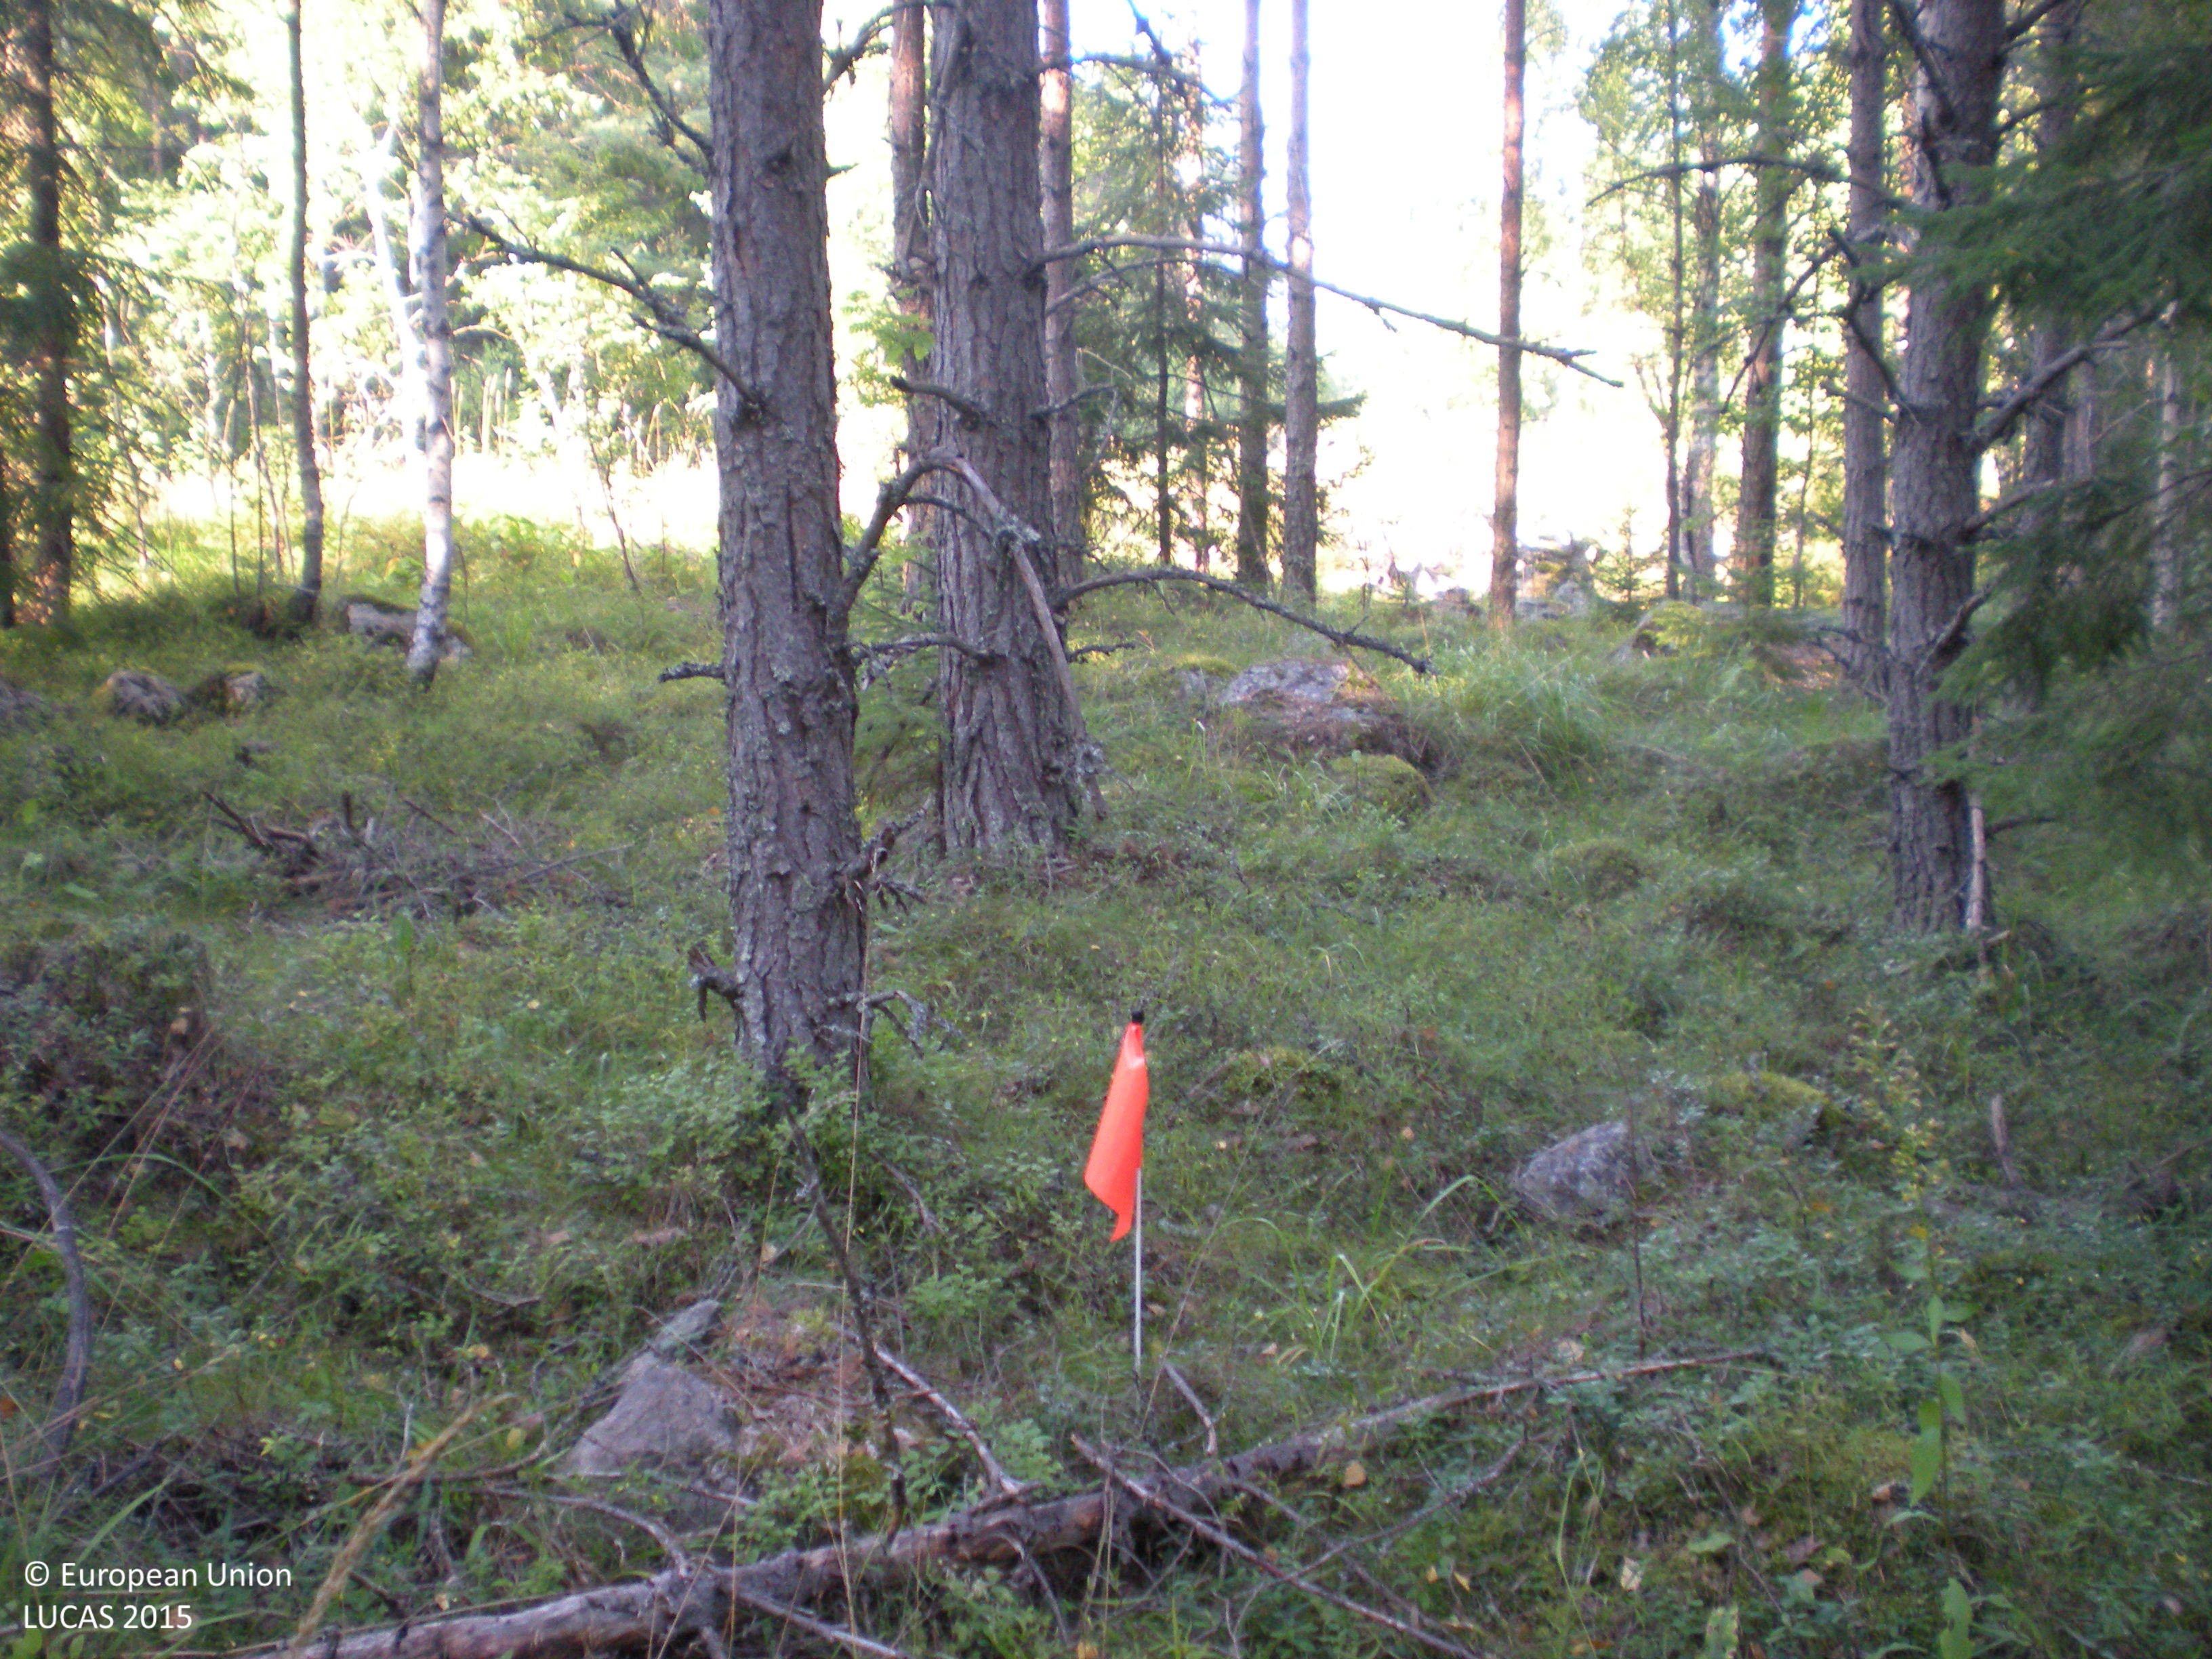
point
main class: Woodland
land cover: Pine dominated coniferous woodland
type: boreal forest
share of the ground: 50 - 75 %
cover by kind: coniferous forest trees 60 %, herbaceous plants 15 %, broadleaved forest trees 10 %, shrubs 10 %, lichens and mosses 5 %
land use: Forestry
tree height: > 5 m
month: August
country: SE
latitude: 60.6059
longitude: 17.3141
